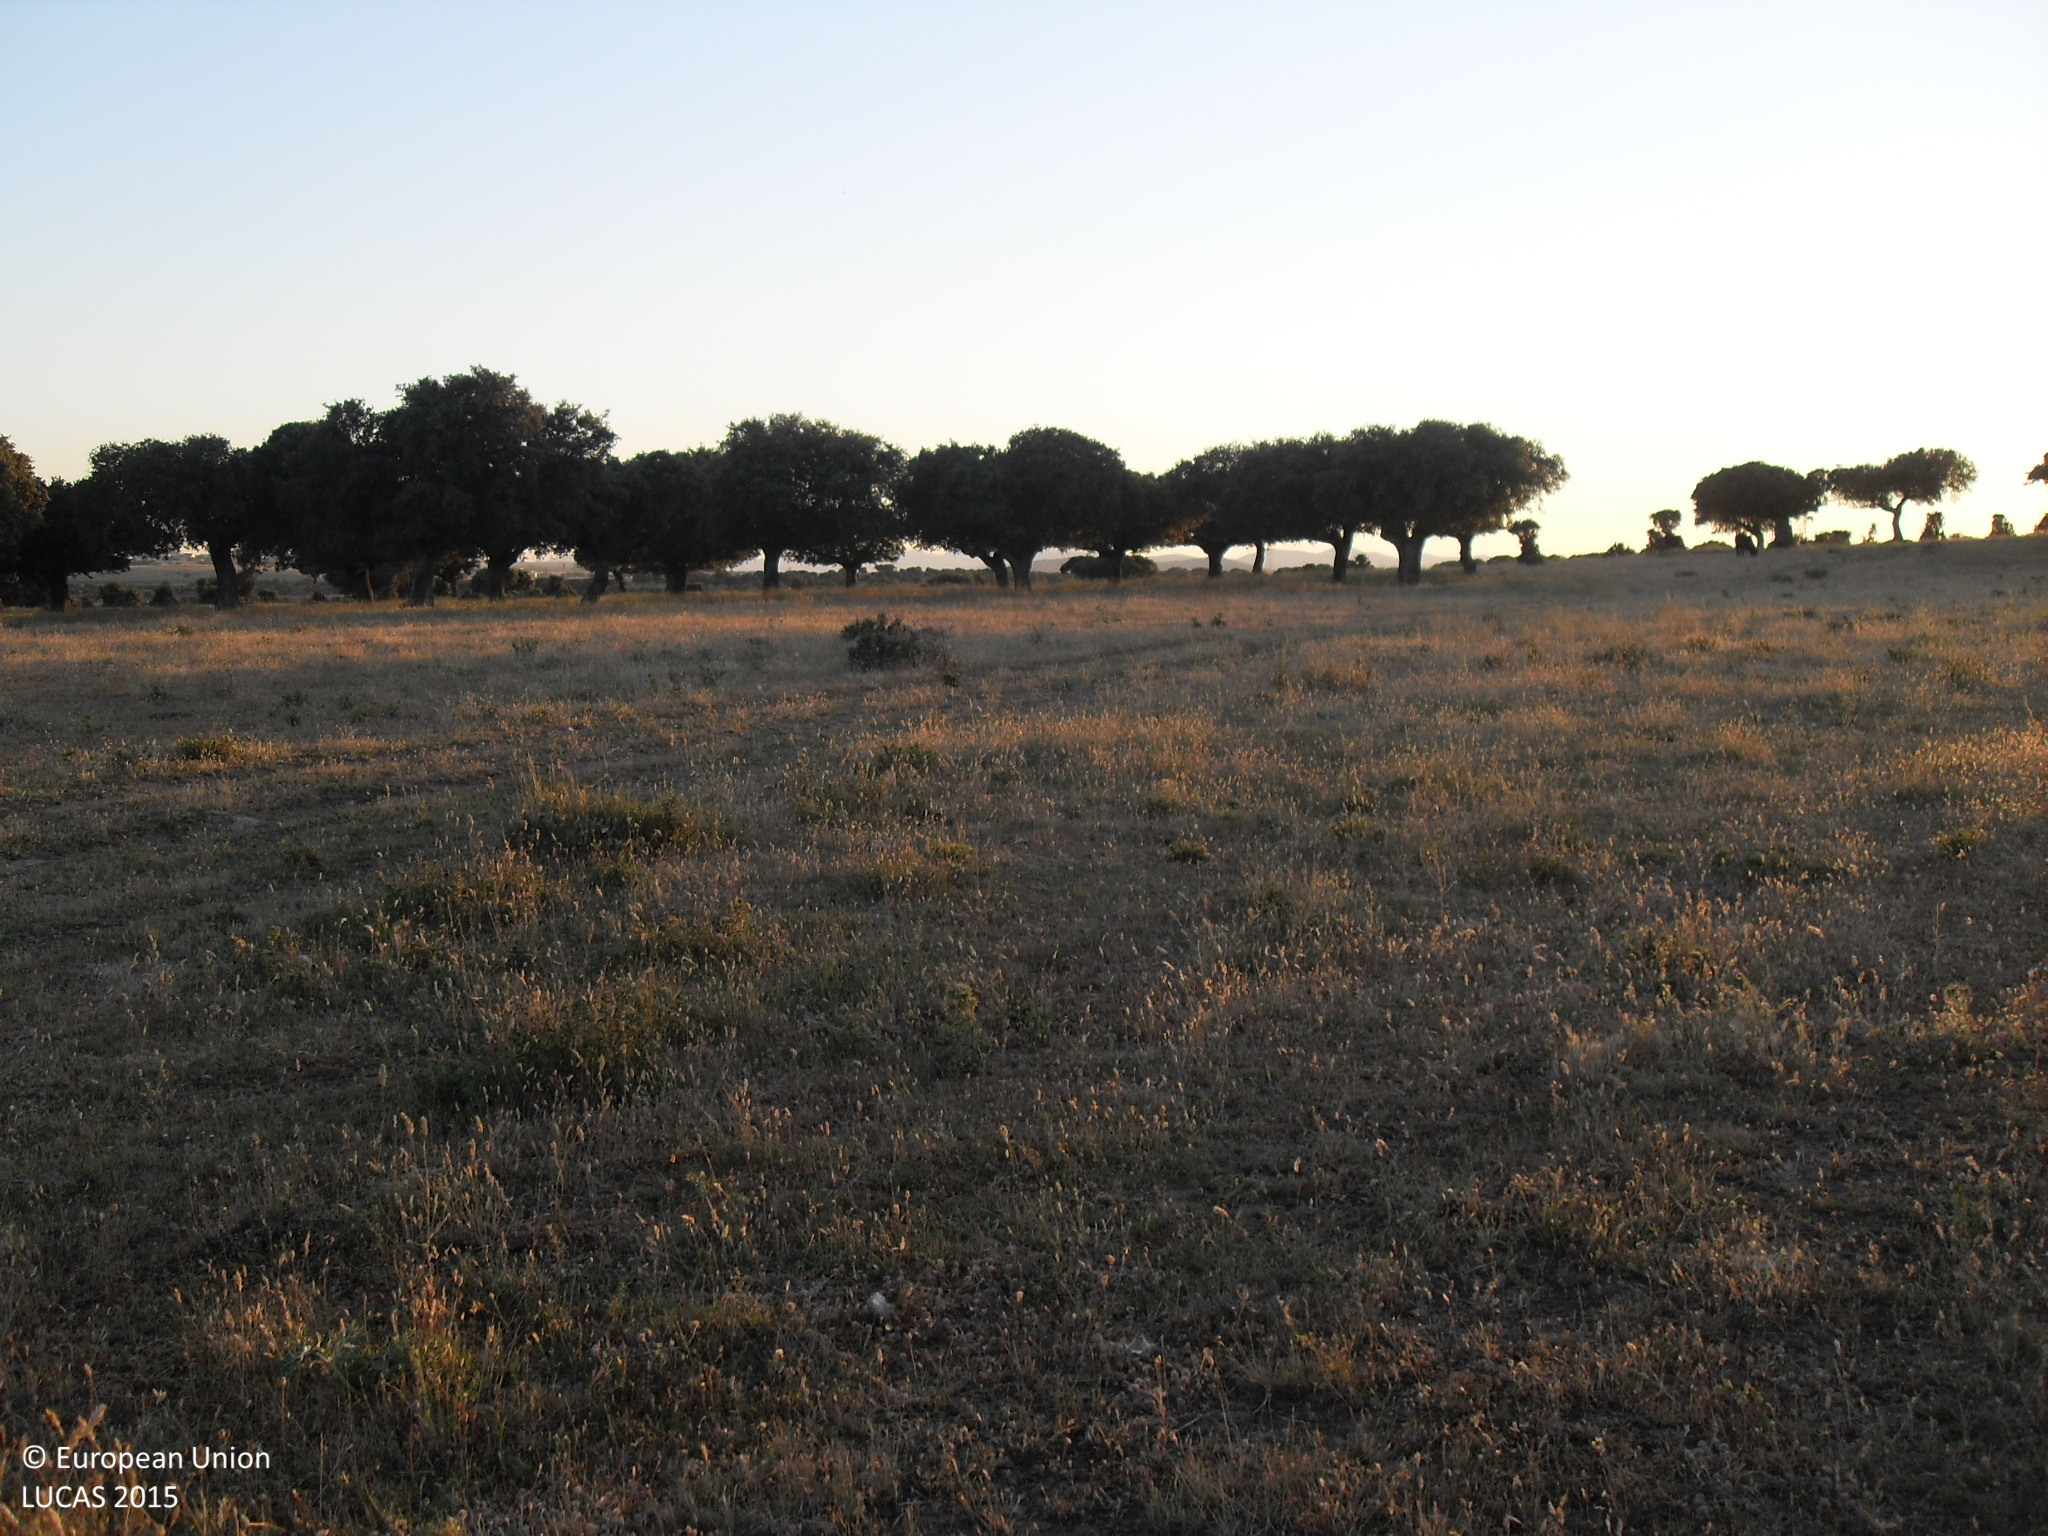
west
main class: Grassland
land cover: Grassland without tree/shrub cover
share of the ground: > 75 %
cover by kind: herbaceous plants 100 %
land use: Agriculture (excluding fallow land and kitchen gardens)
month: June
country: ES
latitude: 40.5867
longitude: -5.6314
